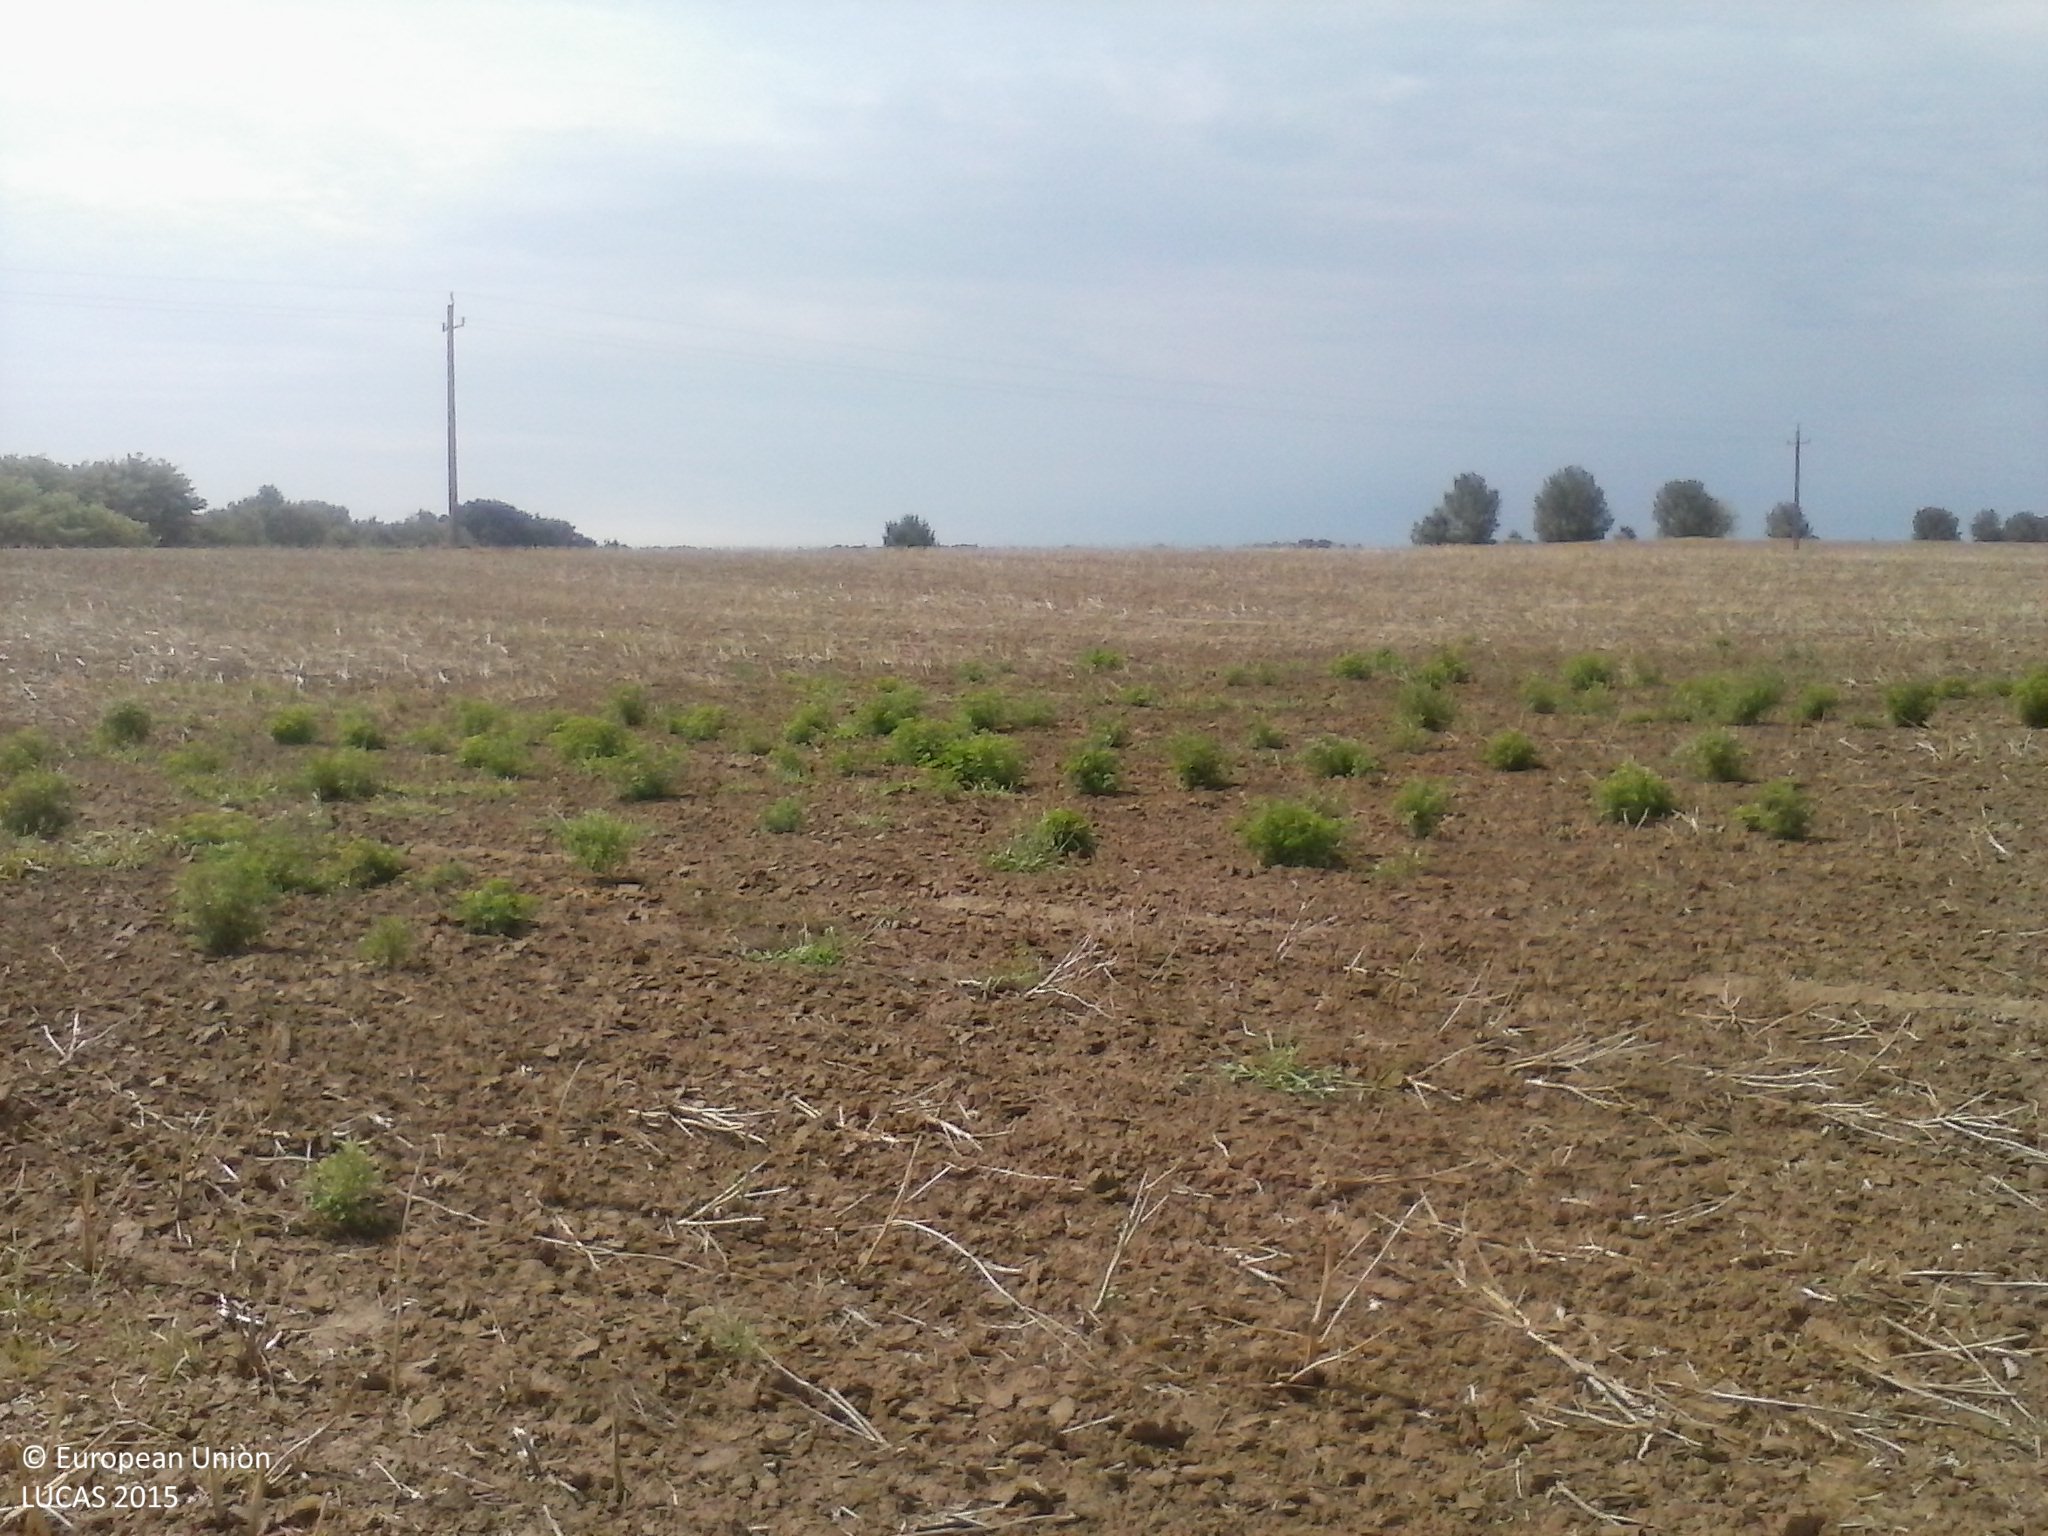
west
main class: Cropland
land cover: Rape and turnip rape
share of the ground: < 10 %
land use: Agriculture (excluding fallow land and kitchen gardens)
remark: Harvested field
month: July
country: HU
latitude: 46.1061
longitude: 17.2344
